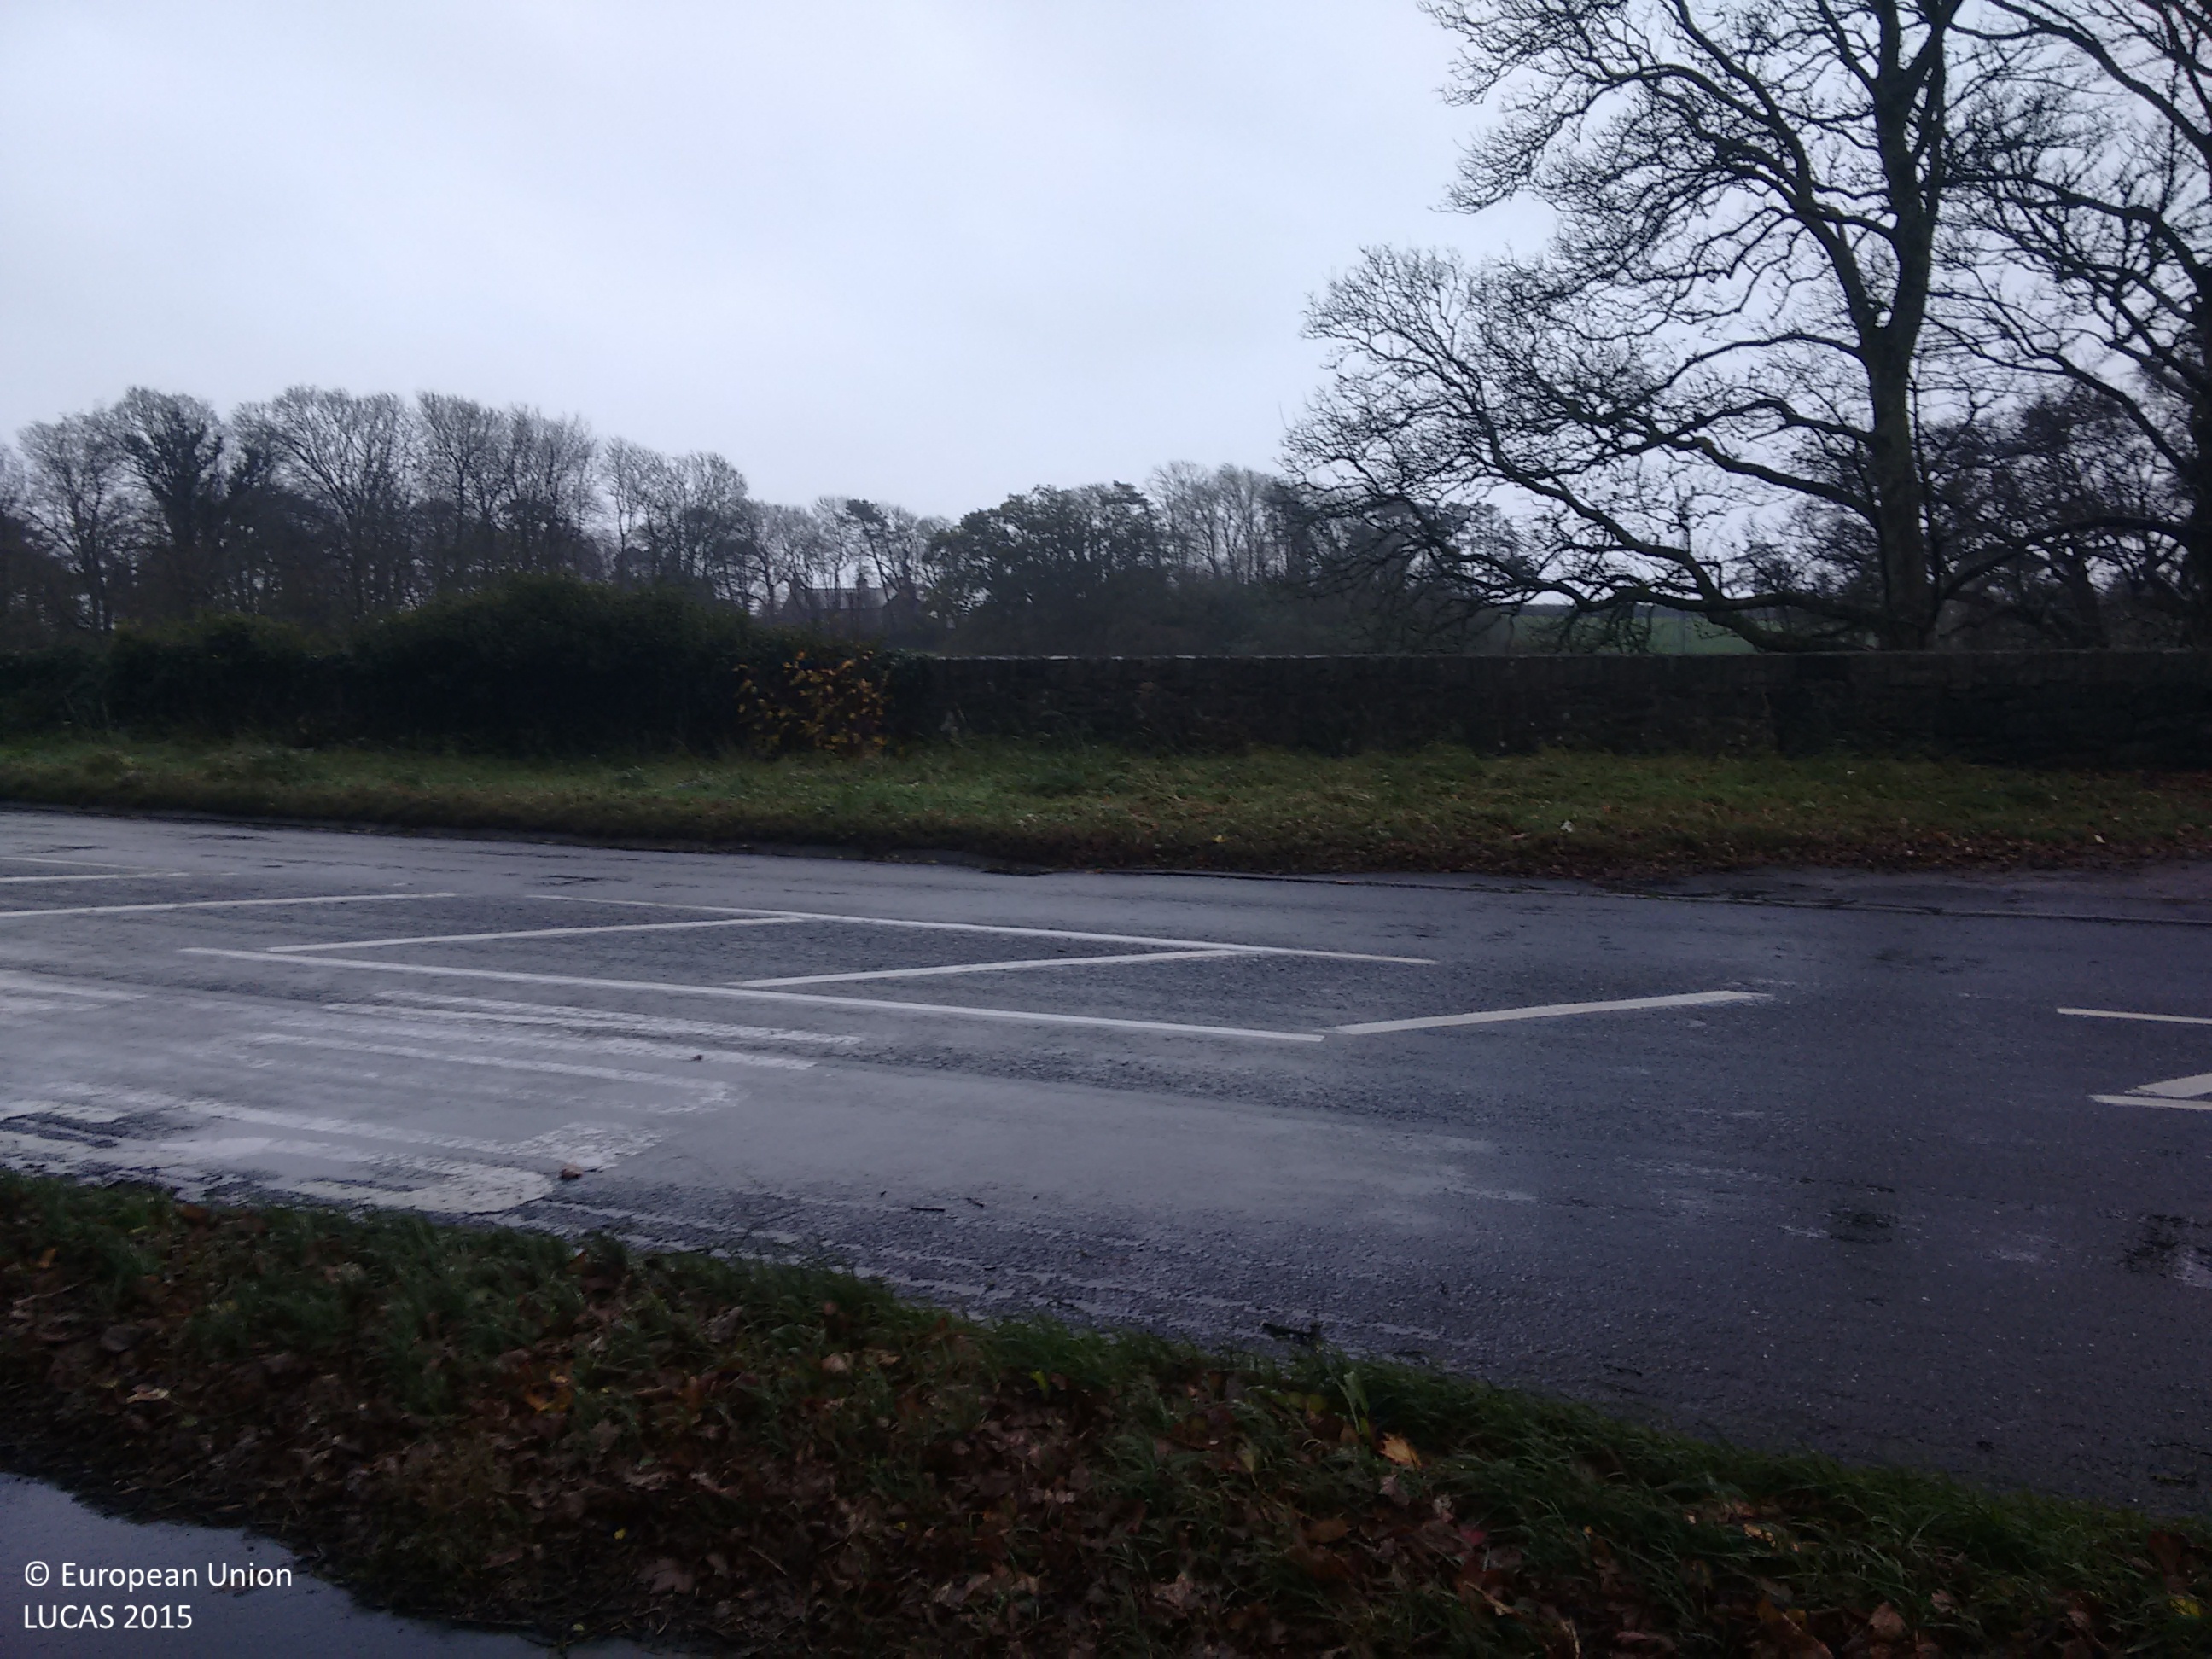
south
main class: Grassland
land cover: Grassland with sparse tree/shrub cover
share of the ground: > 75 %
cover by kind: herbaceous plants 95 %, broadleaved forest trees 5 %
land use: Amenities, museums, leisure
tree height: > 5 m
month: November
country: GB
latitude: 52.9195
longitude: -4.2437
